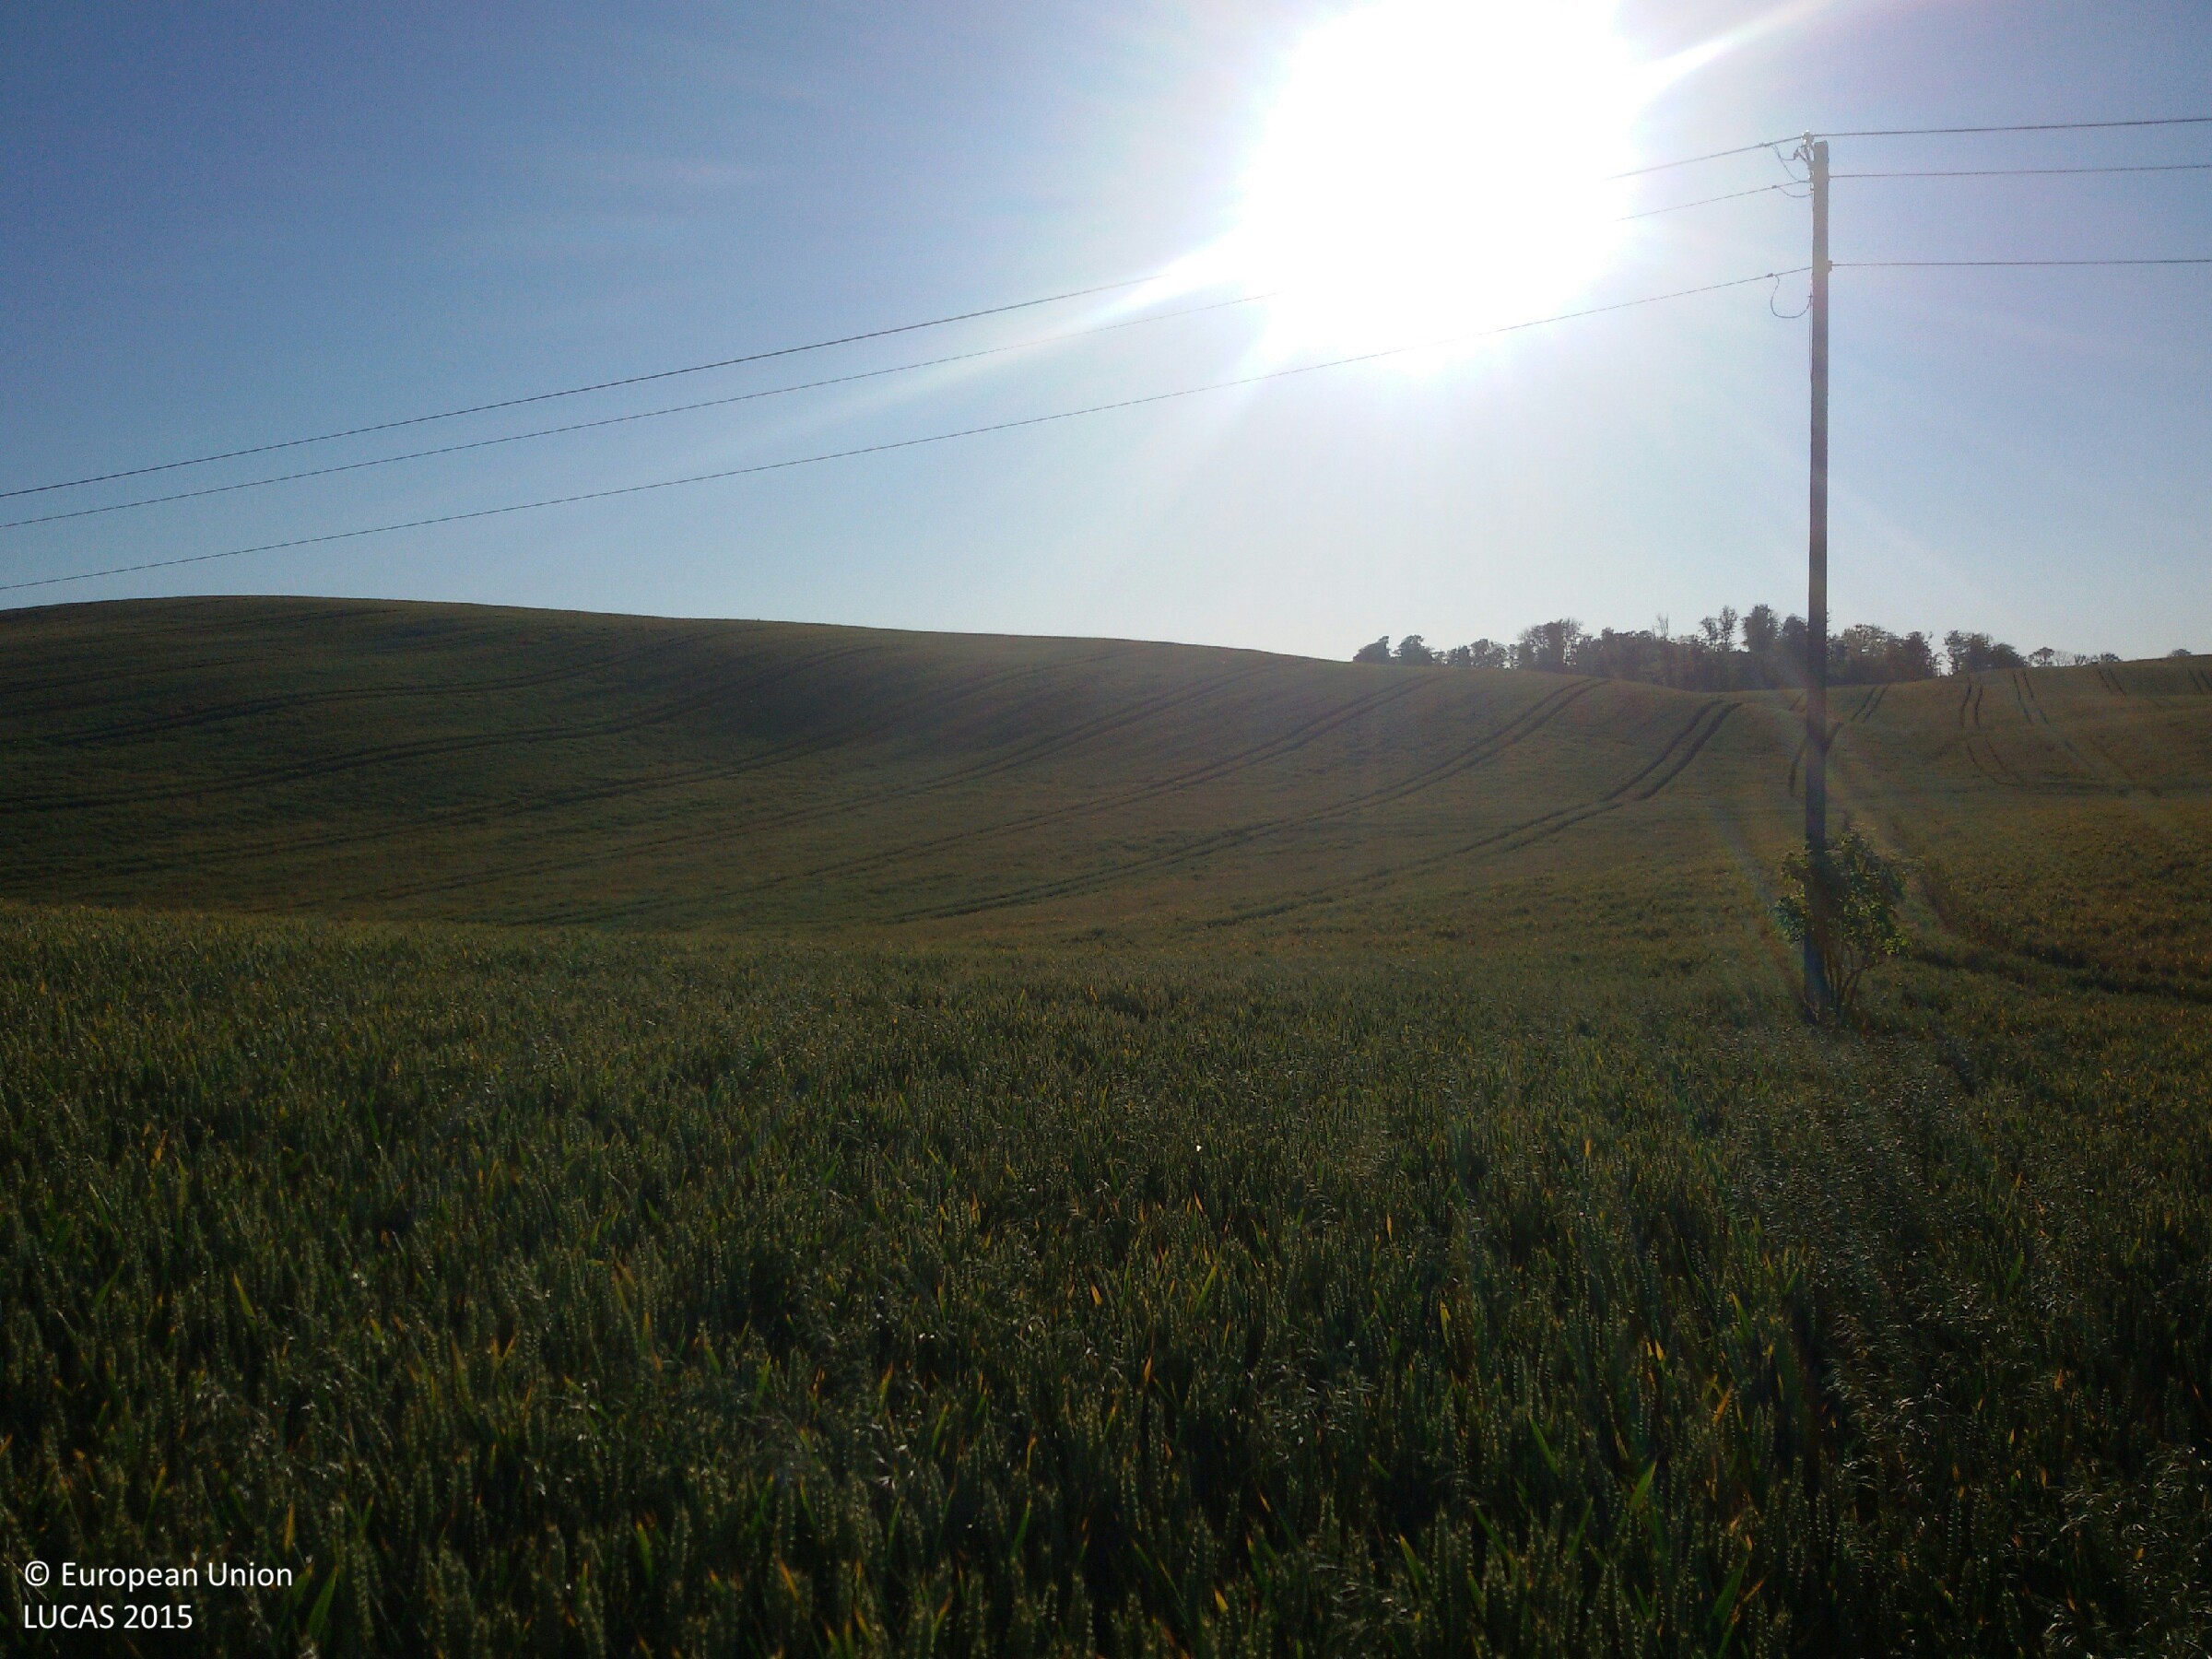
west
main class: Cropland
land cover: Common wheat
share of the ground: > 75 %
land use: Agriculture (excluding fallow land and kitchen gardens)
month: July
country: PL
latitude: 53.8925
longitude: 19.3218
